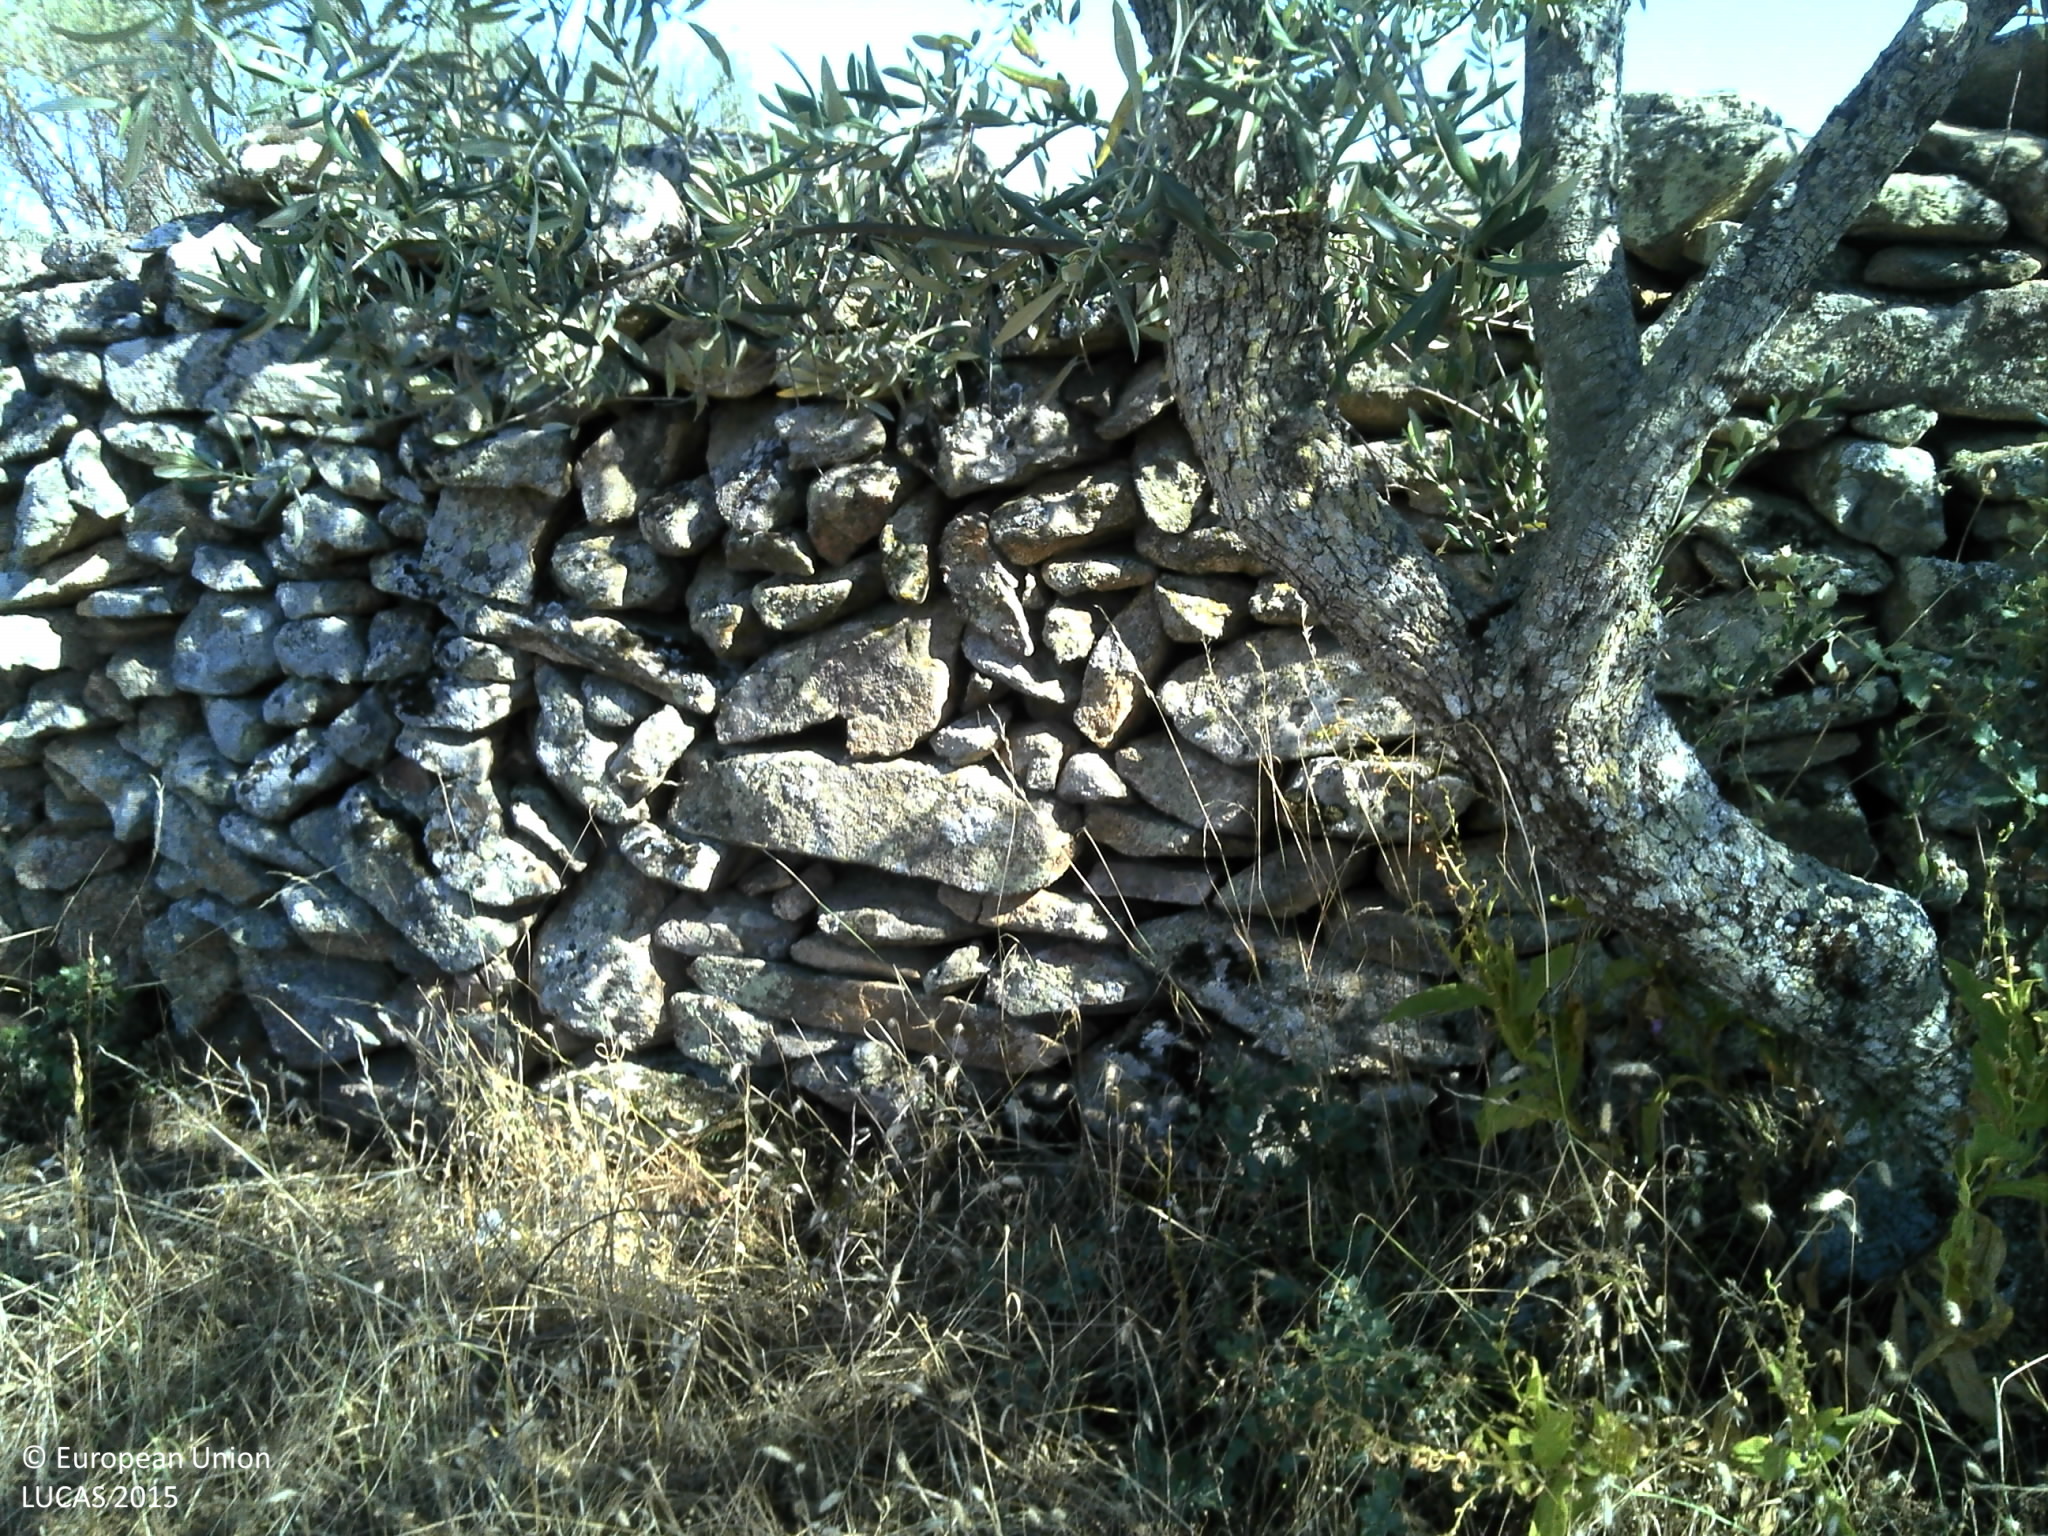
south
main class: Cropland
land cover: Olive groves
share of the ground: 10 - 25 %
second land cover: Spontaneously vegetated surfaces
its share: 25 - 50 %
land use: Agriculture (excluding fallow land and kitchen gardens)
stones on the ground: 10 - 25 %
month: June
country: PT
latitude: 40.9679
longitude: -7.0889
